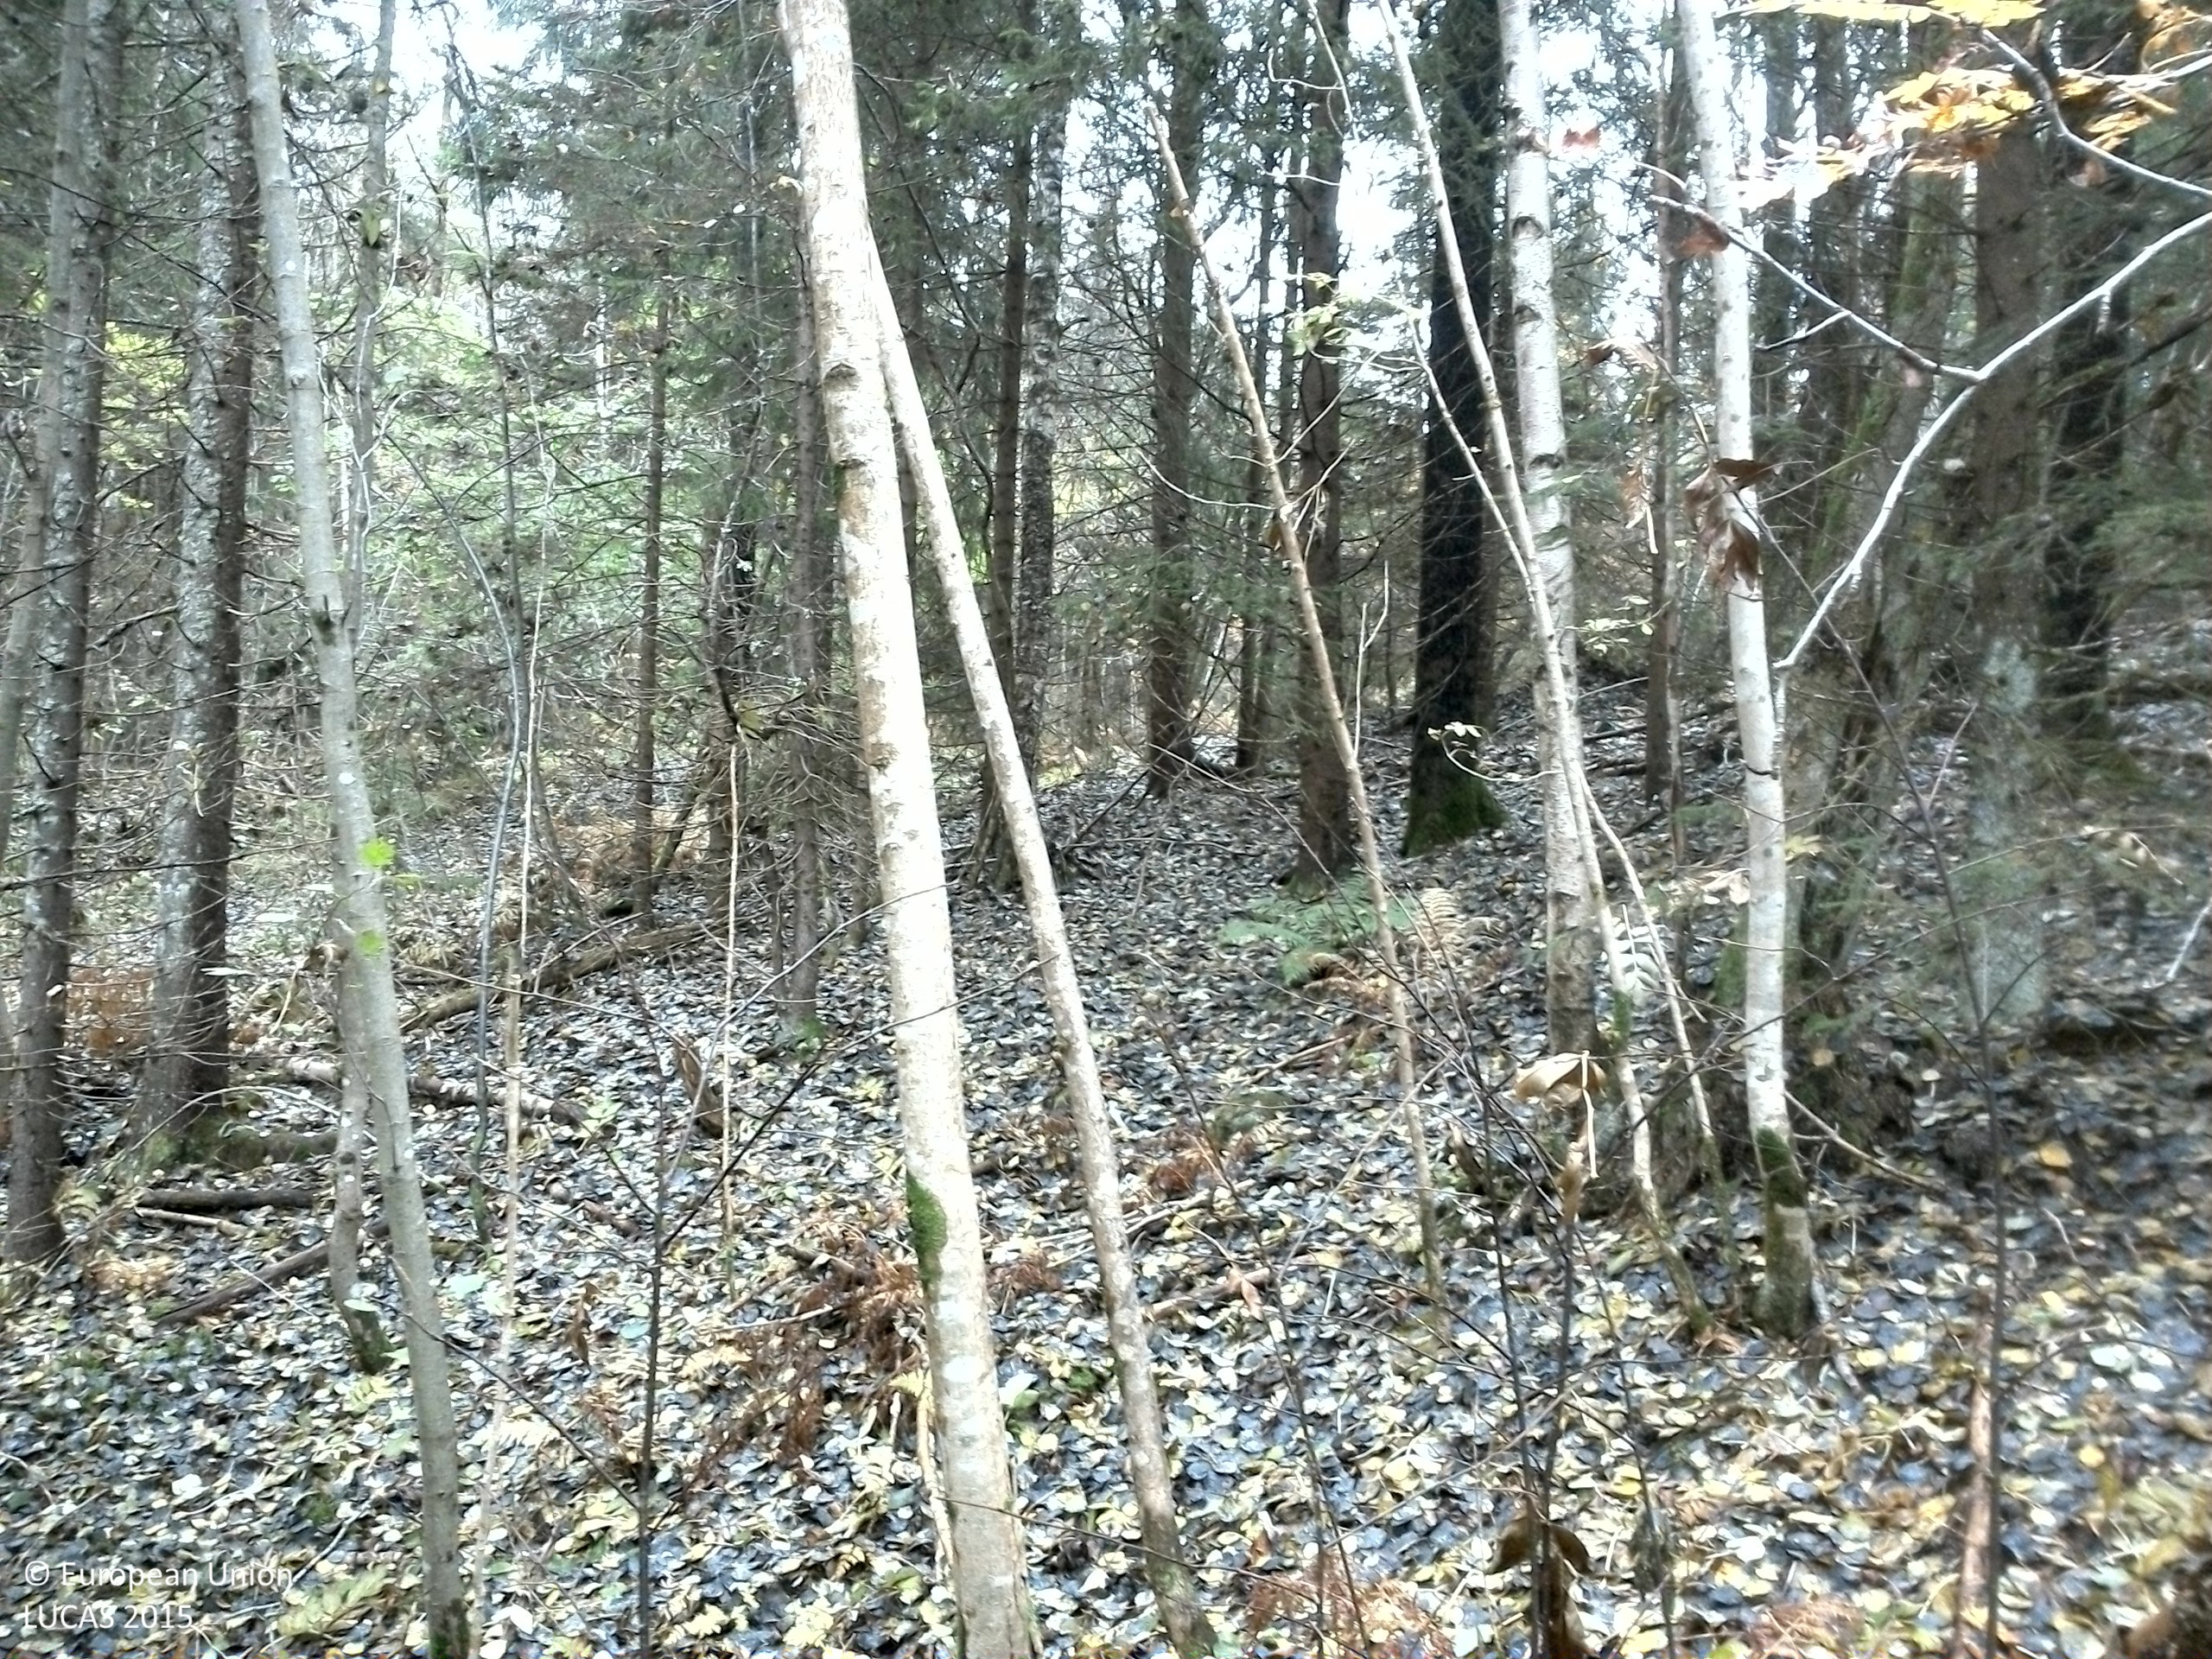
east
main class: Woodland
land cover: Spruce dominated mixed woodland
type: boreal forest
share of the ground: 50 - 75 %
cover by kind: coniferous forest trees 45 %, broadleaved forest trees 20 %, shrubs 15 %, herbaceous plants 10 %, lichens and mosses 10 %
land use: Forestry
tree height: > 5 m
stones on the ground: 10 - 25 %
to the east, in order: Spruce dominated mixed woodland; Rivers and streams; Spruce dominated mixed woodland; Spruce dominated coniferous woodland; Pine dominated coniferous woodland; Tracks; Pine dominated coniferous woodland
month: October
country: SE
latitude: 59.7240
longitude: 15.2005
